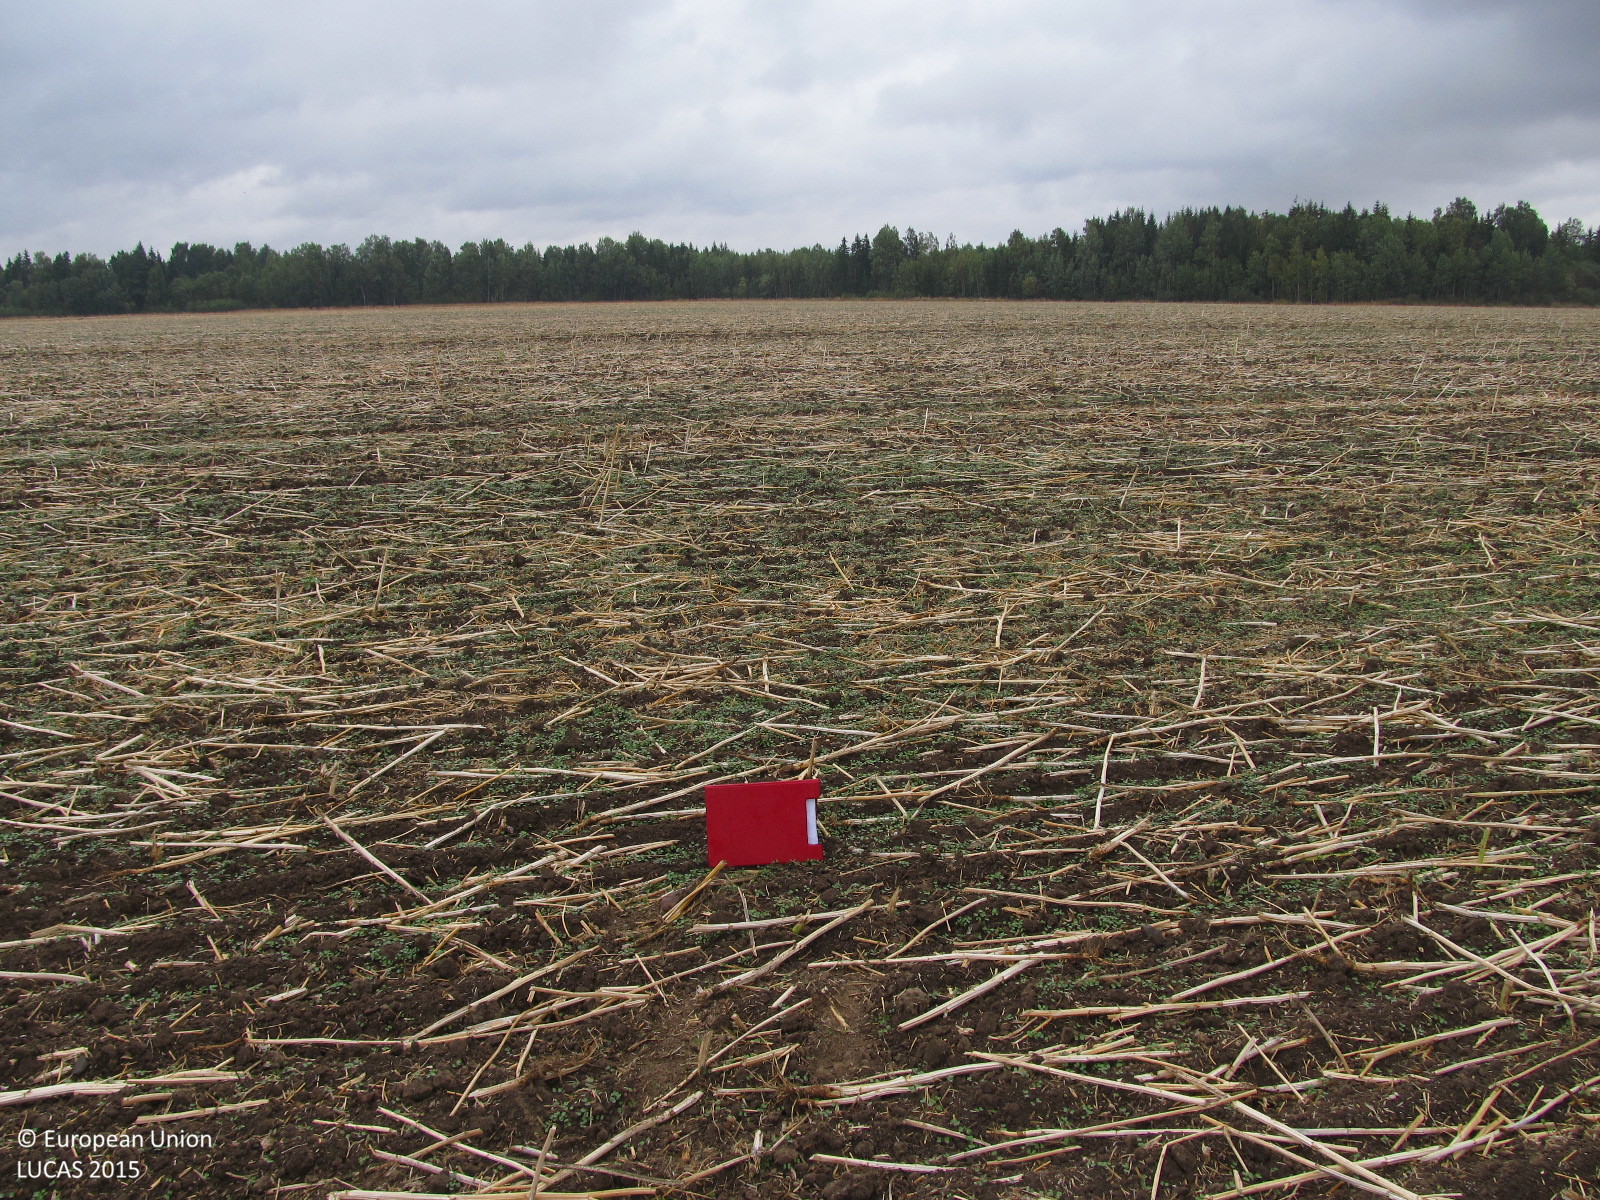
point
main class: Cropland
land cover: Rape and turnip rape
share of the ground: 25 - 50 %
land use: Agriculture (excluding fallow land and kitchen gardens)
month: August
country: LT
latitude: 55.9689
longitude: 23.0954
